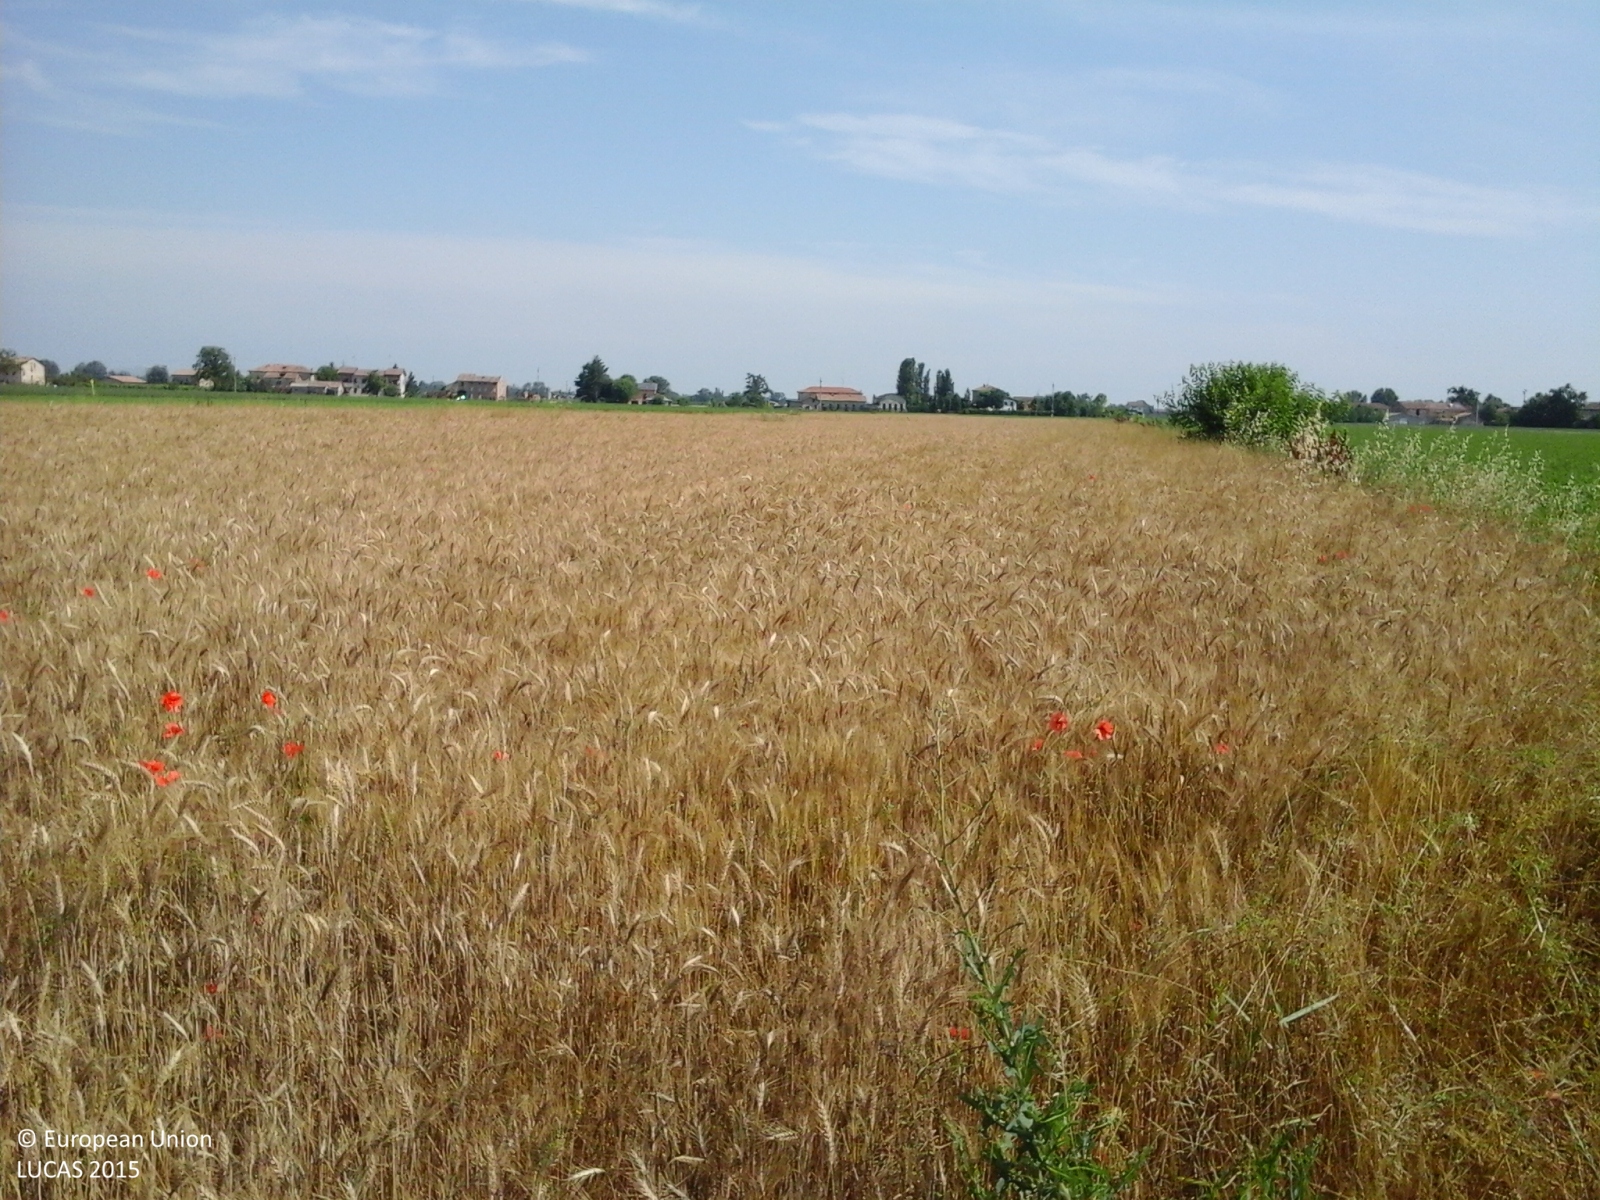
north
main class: Cropland
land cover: Durum wheat
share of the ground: > 75 %
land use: Agriculture (excluding fallow land and kitchen gardens)
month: June
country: IT
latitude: 44.7266
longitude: 10.7434
